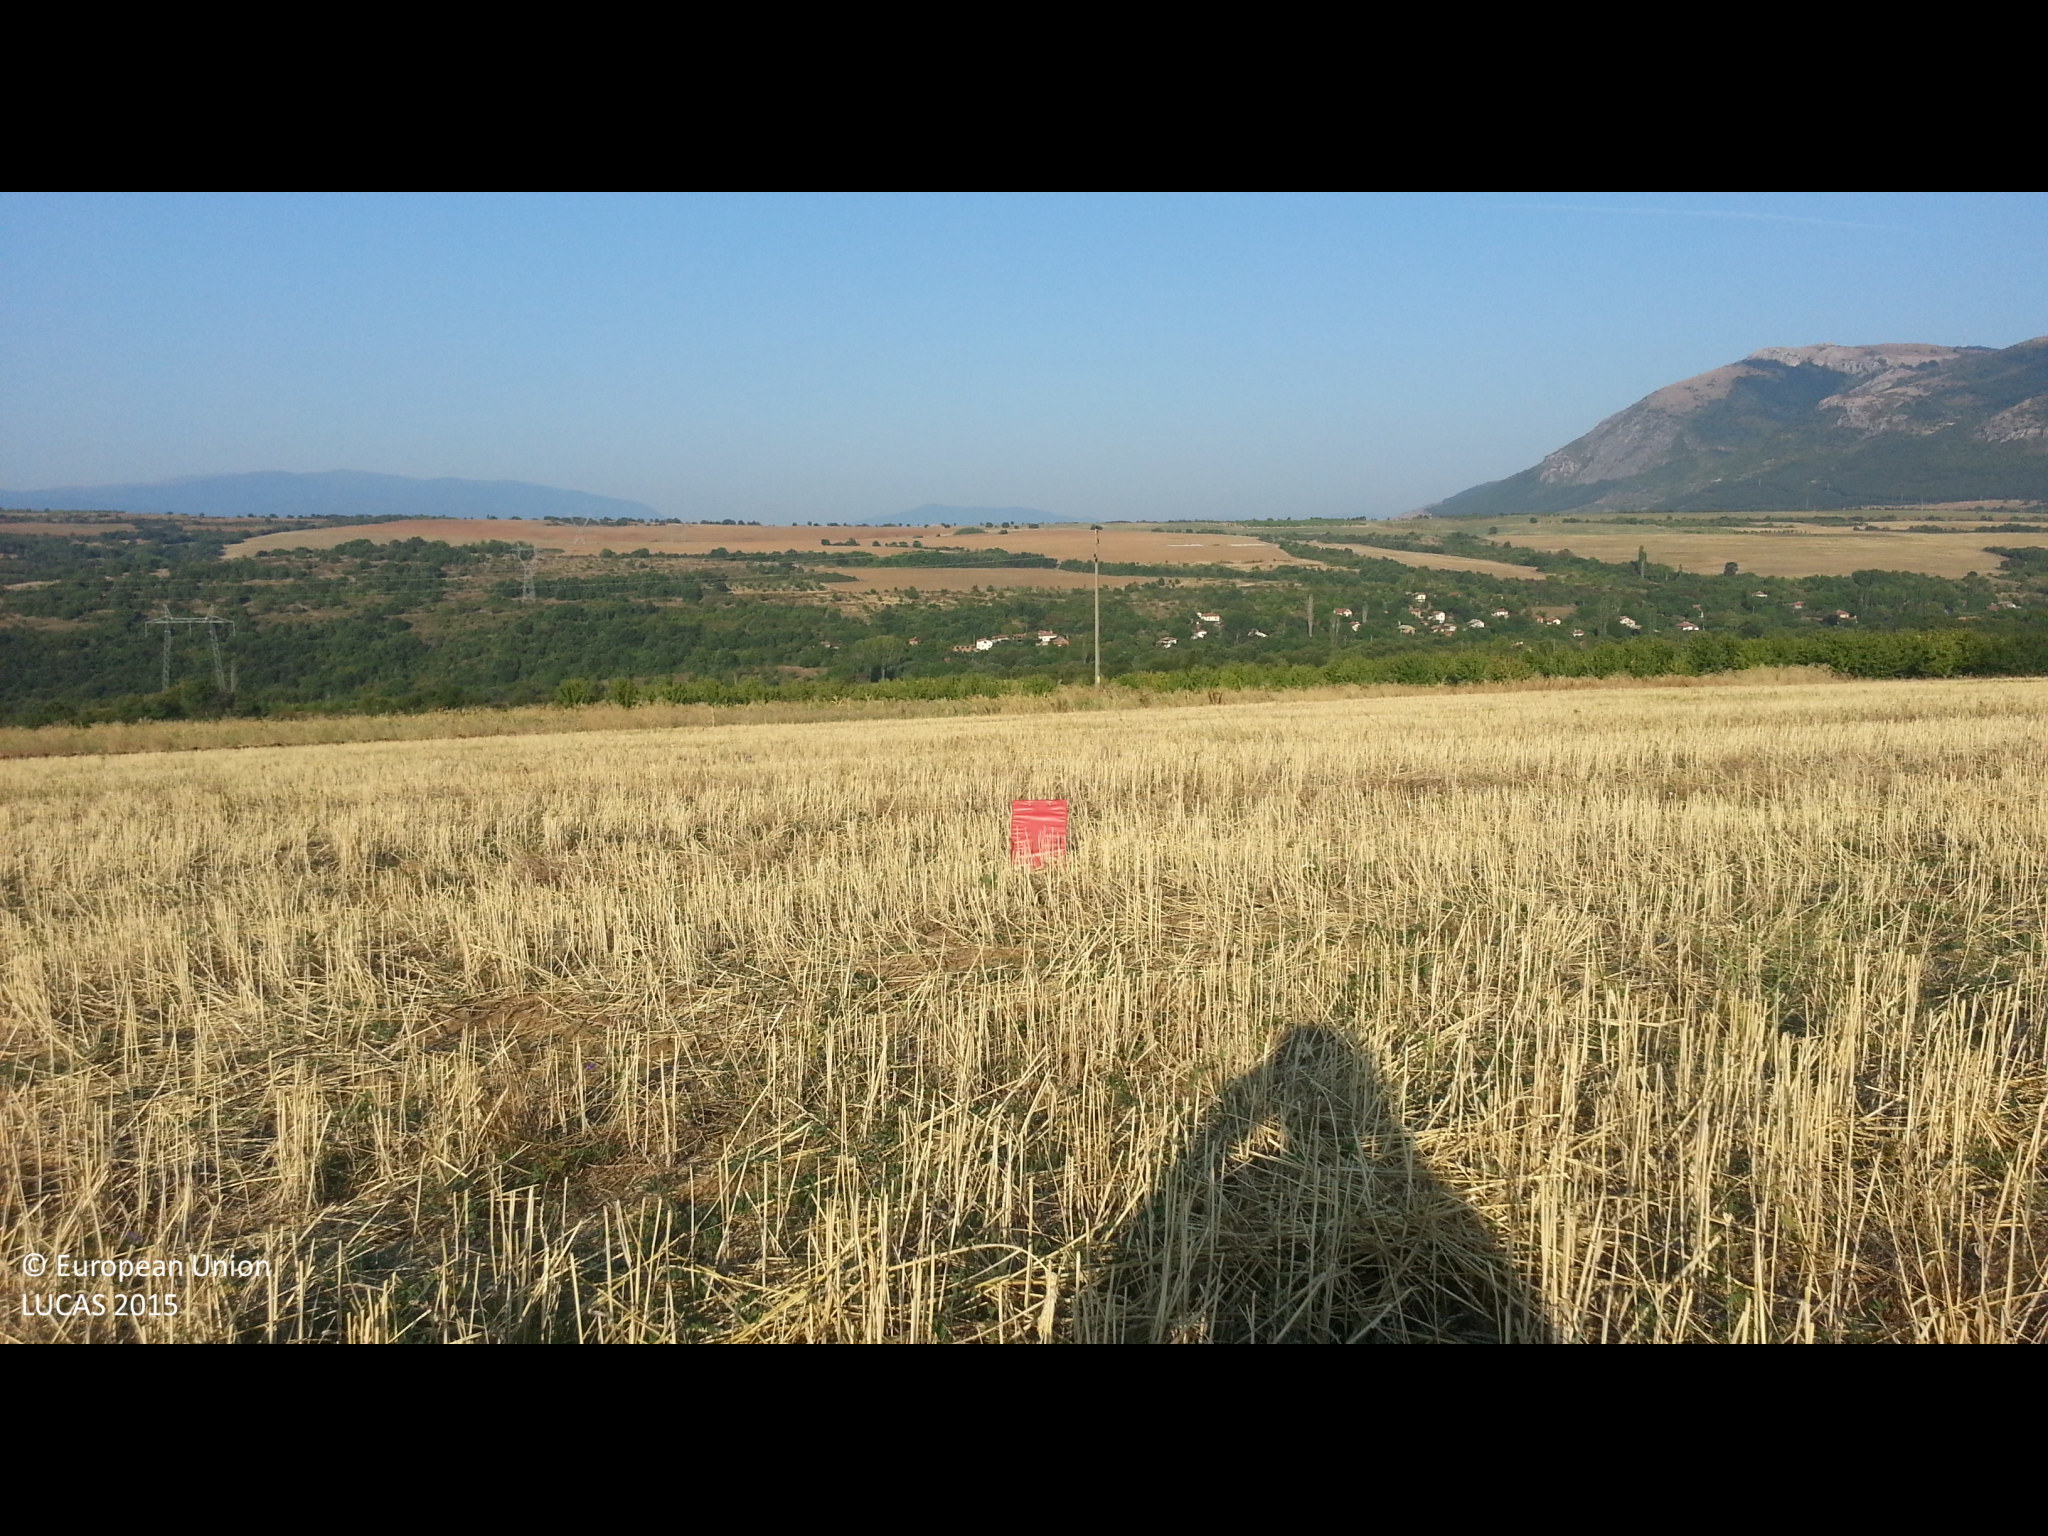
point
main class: Cropland
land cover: Common wheat
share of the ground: 50 - 75 %
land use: Agriculture (excluding fallow land and kitchen gardens)
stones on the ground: < 10 %
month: September
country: BG
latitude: 42.3156
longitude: 22.9223
